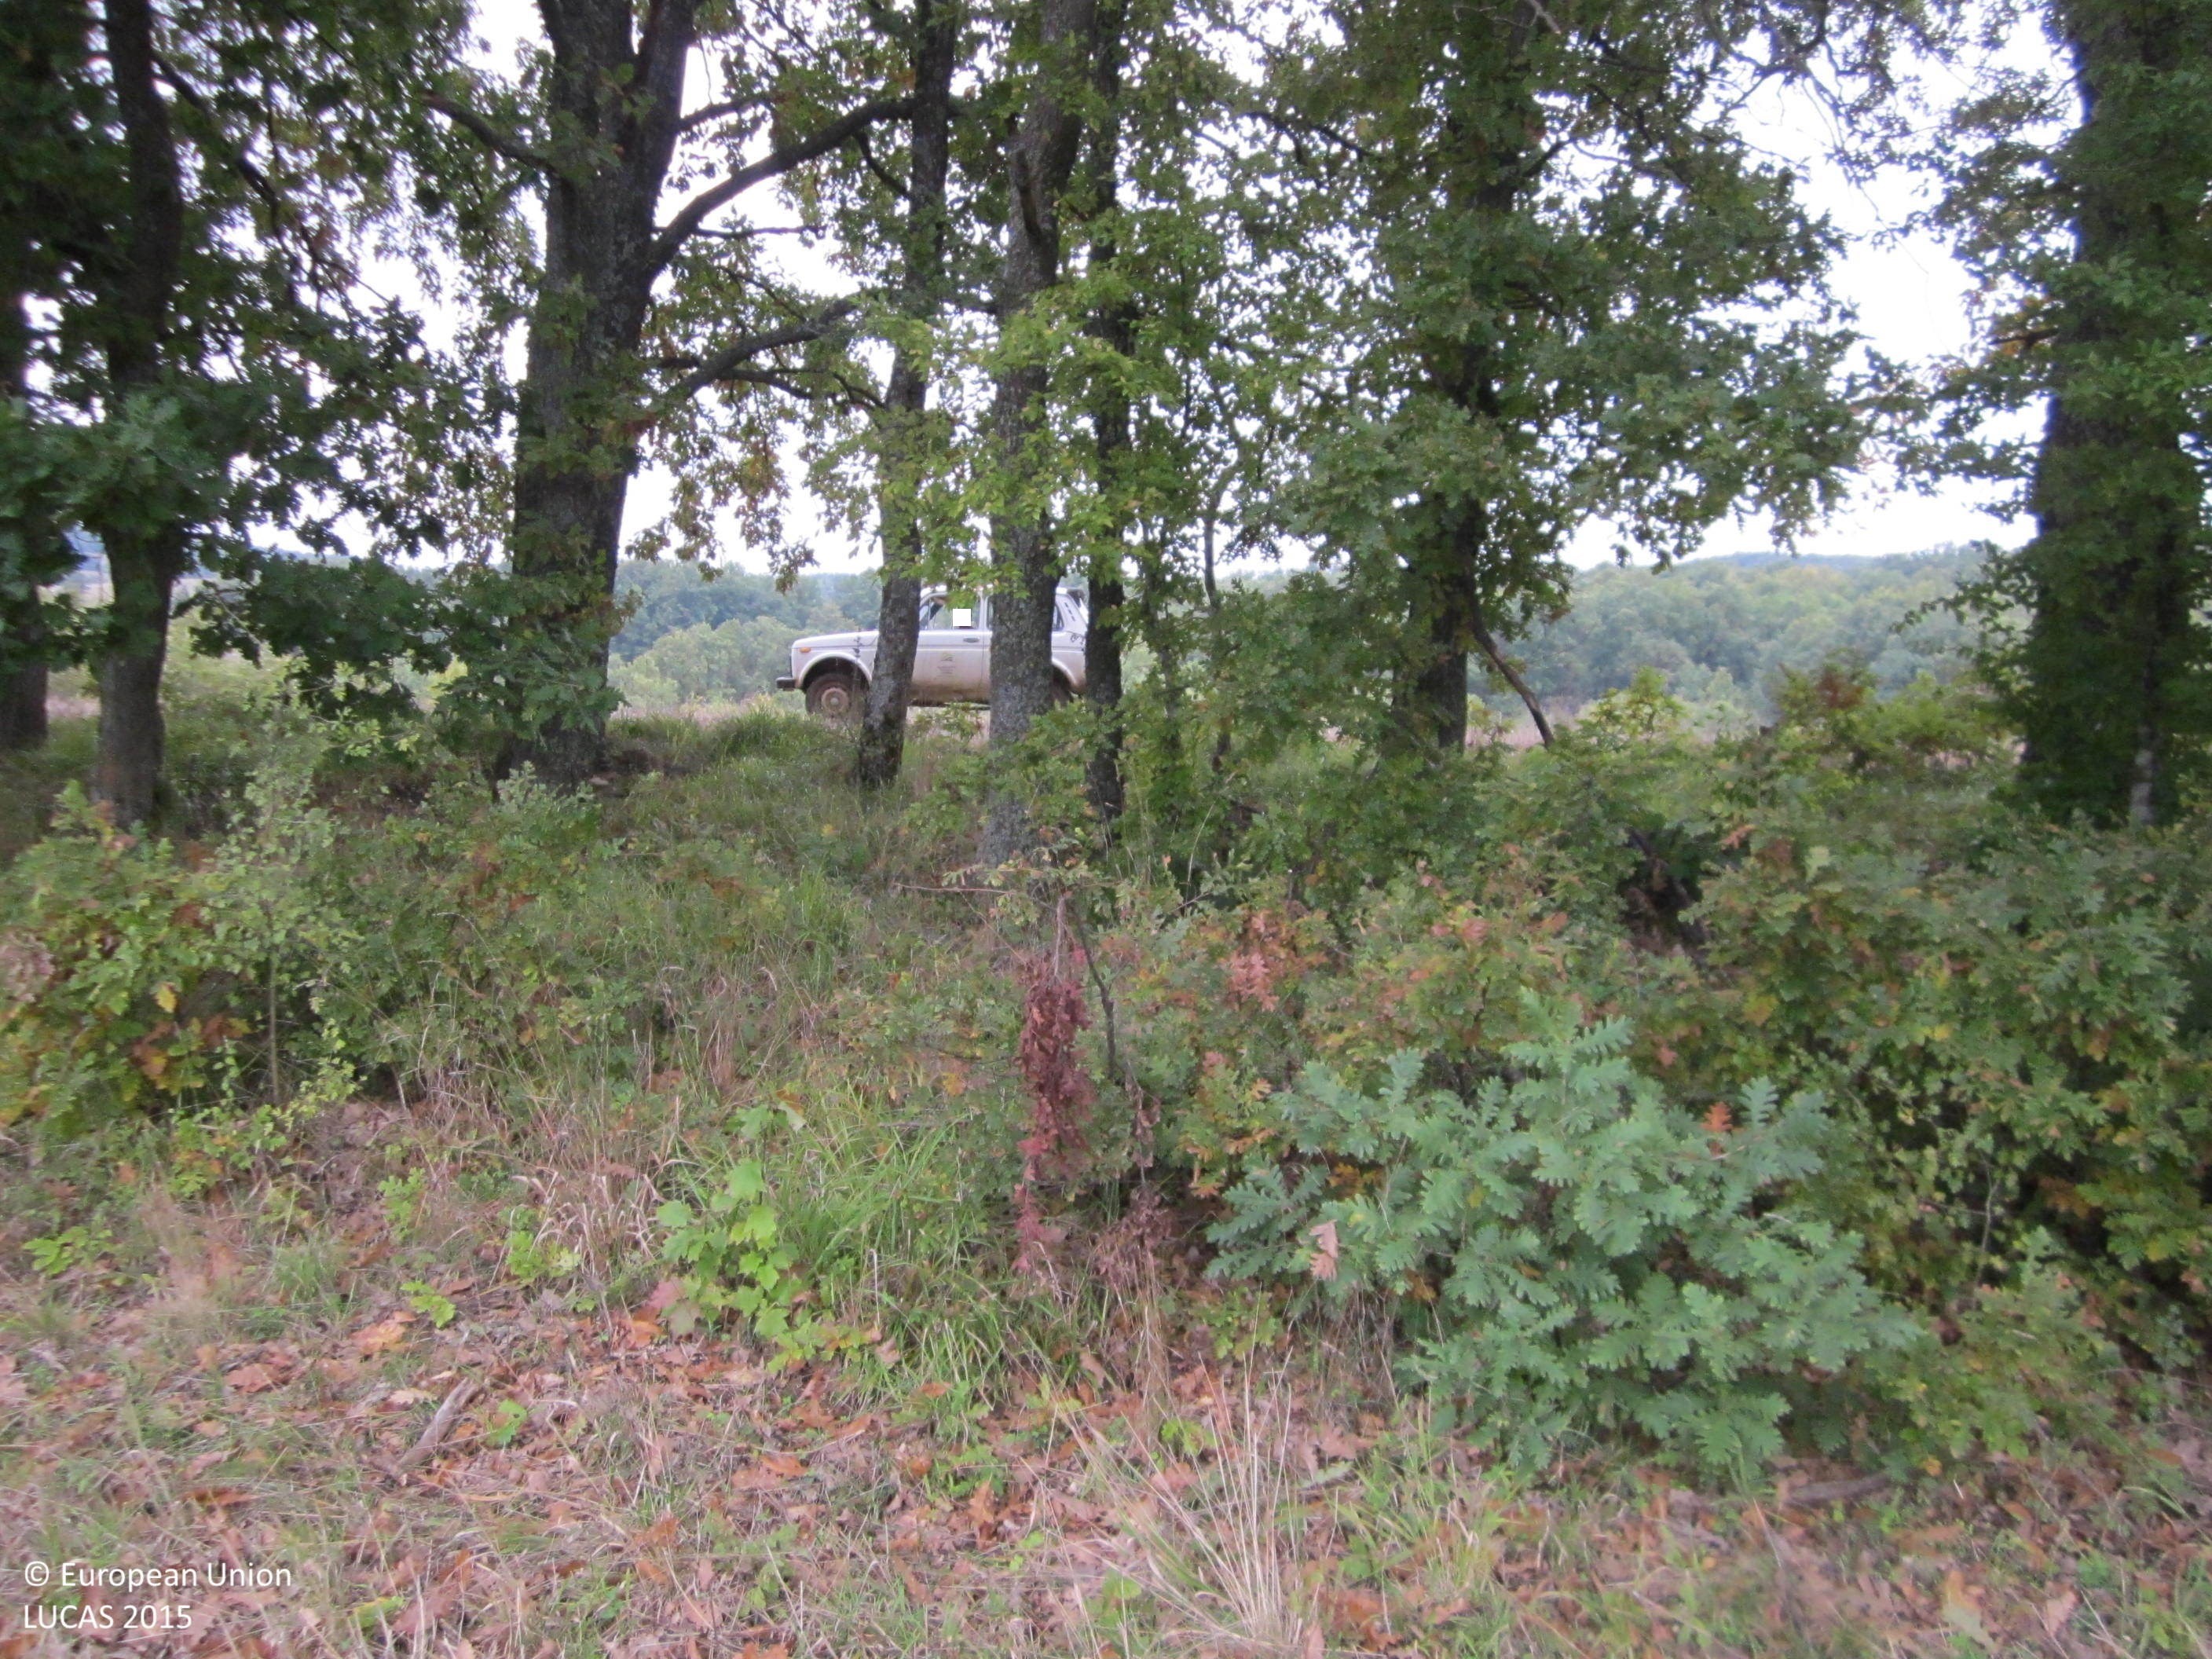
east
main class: Grassland
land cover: Grassland without tree/shrub cover
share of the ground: > 75 %
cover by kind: herbaceous plants 100 %
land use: Agriculture (excluding fallow land and kitchen gardens)
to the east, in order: Grassland without tree/shrub cover; Broadleaved woodland; Grassland without tree/shrub cover; Broadleaved woodland; Grassland with sparse tree/shrub cover; Broadleaved woodland; Ditches and canals; Broadleaved woodland
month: October
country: BG
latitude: 42.2260
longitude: 27.3756
